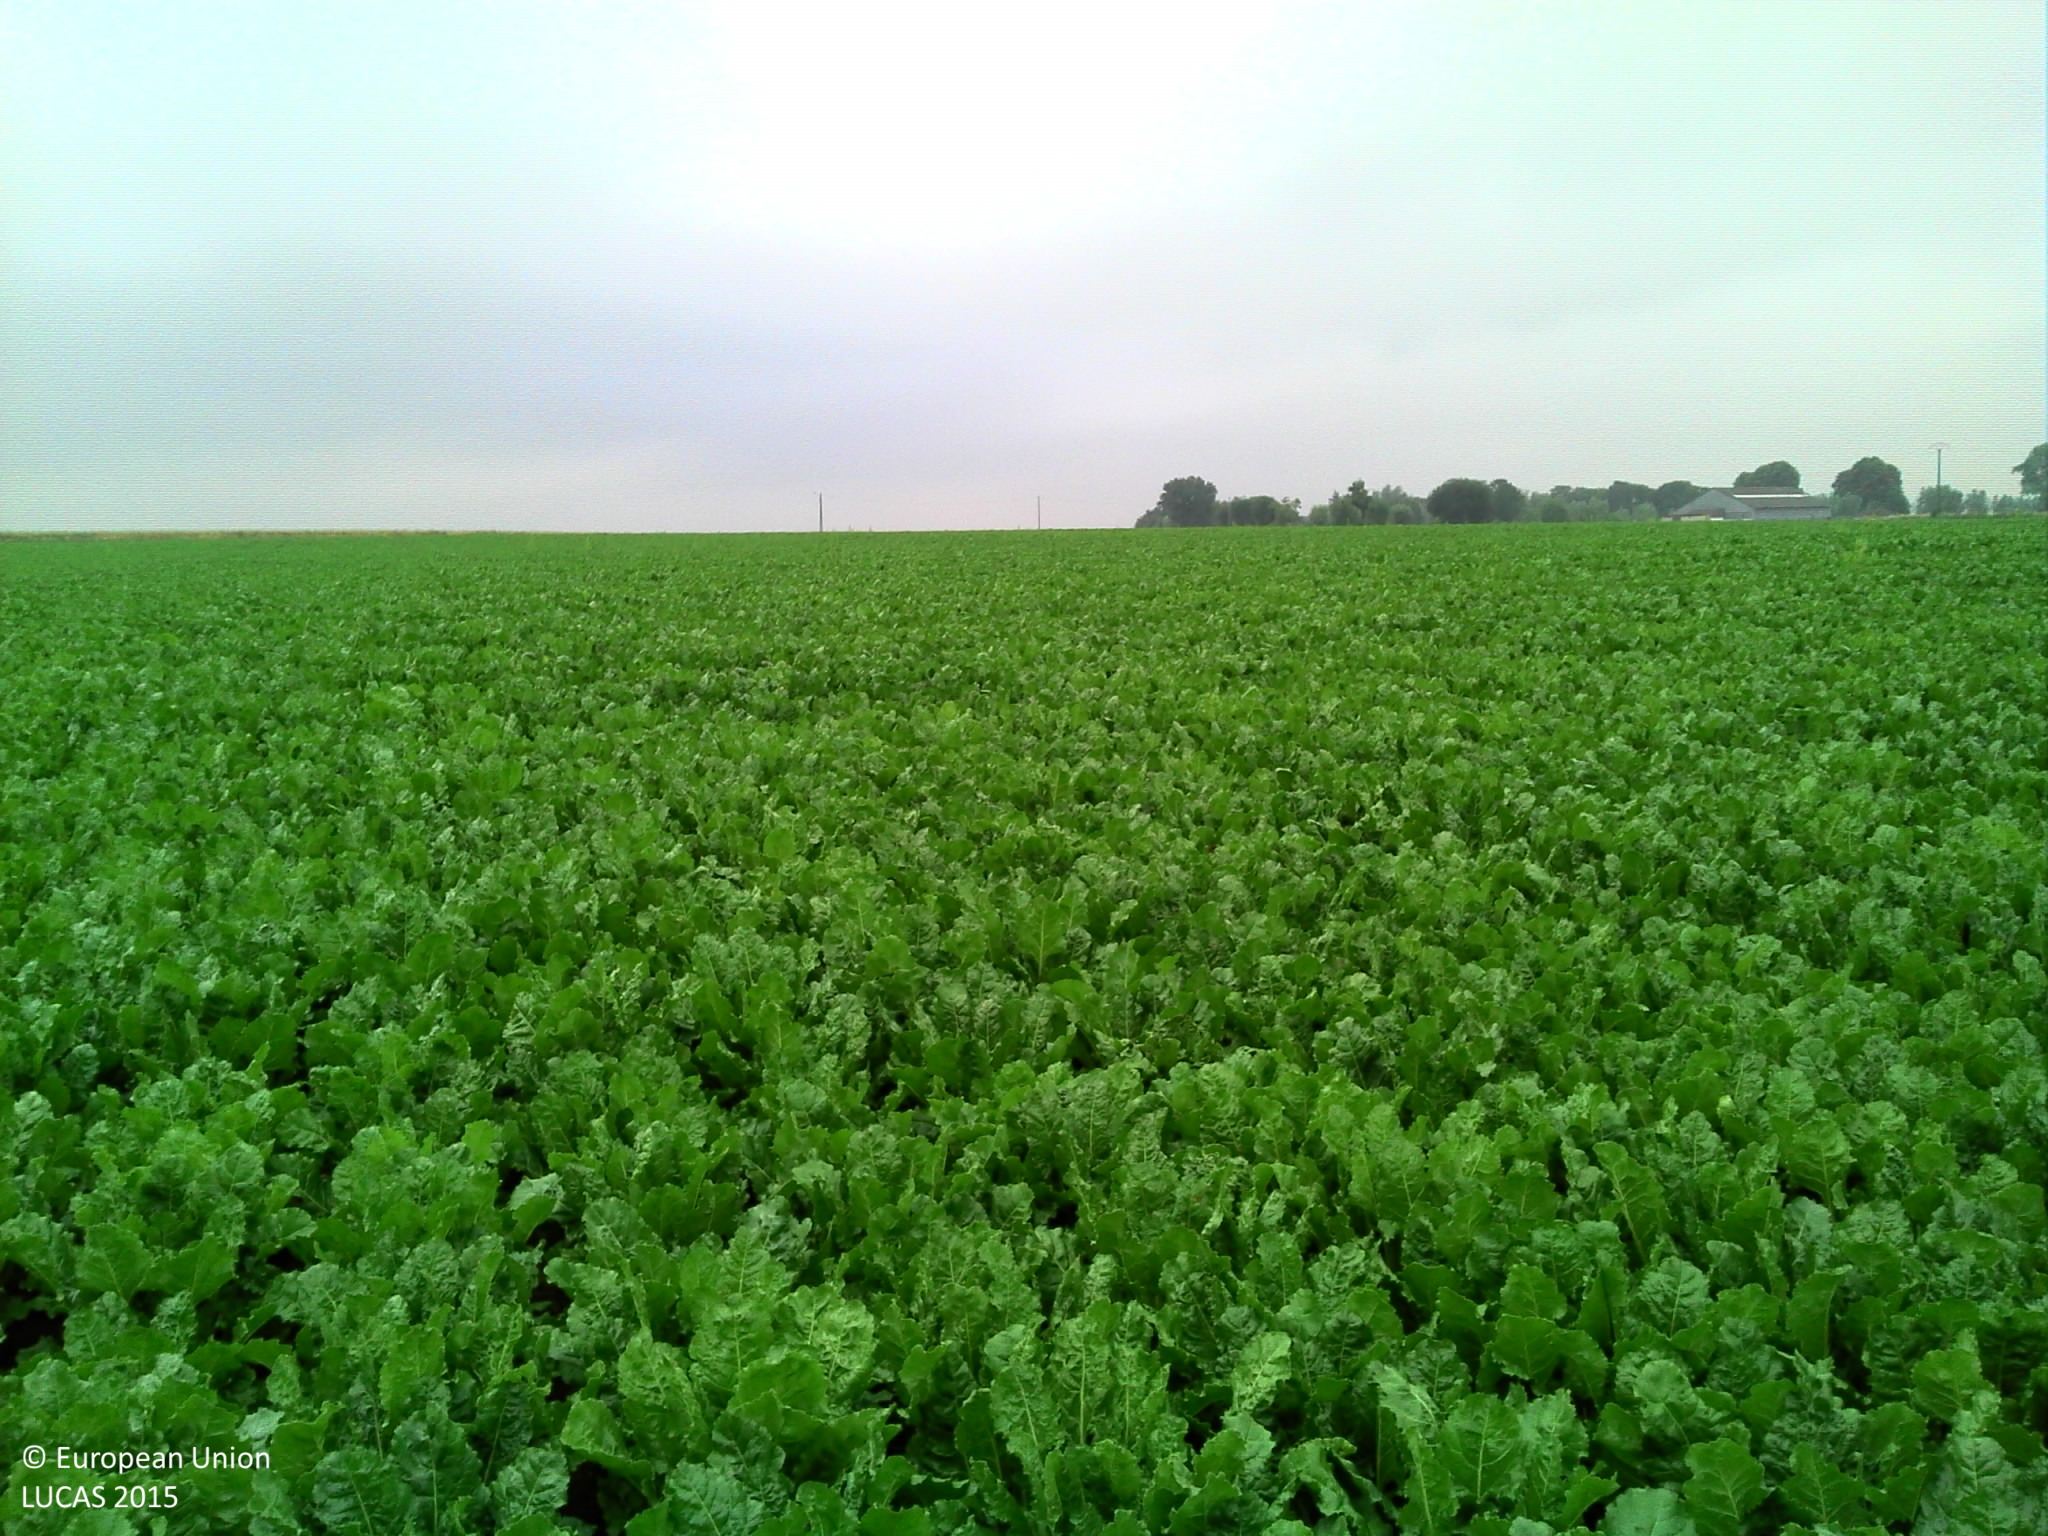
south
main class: Cropland
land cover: Sugar beet
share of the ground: > 75 %
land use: Agriculture (excluding fallow land and kitchen gardens)
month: July
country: BE
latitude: 50.3534
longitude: 4.0493
